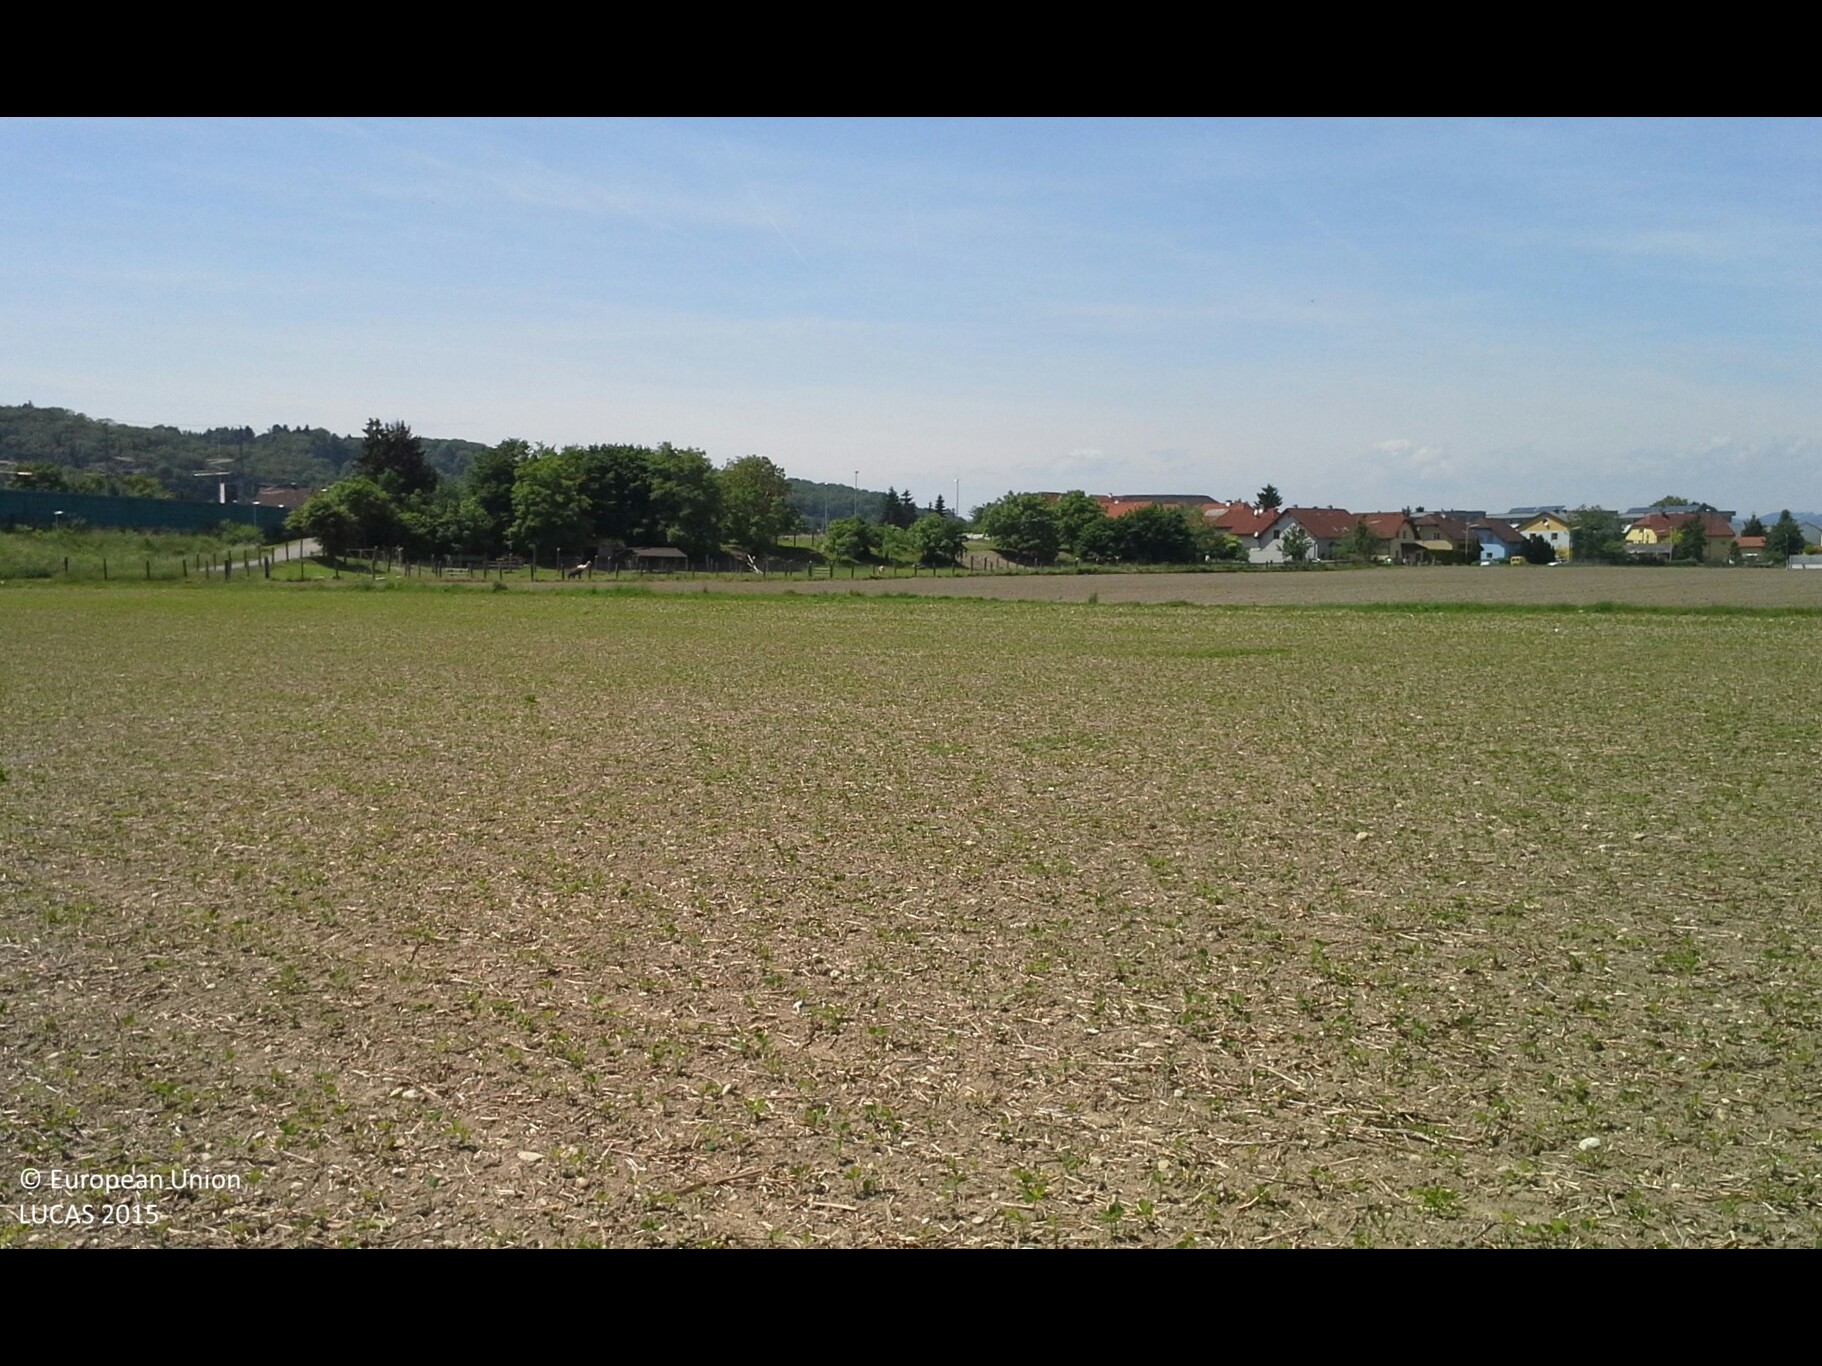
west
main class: Cropland
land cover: Soya
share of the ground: 10 - 25 %
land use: Agriculture (excluding fallow land and kitchen gardens)
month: May
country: AT
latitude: 48.2448
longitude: 14.3767
